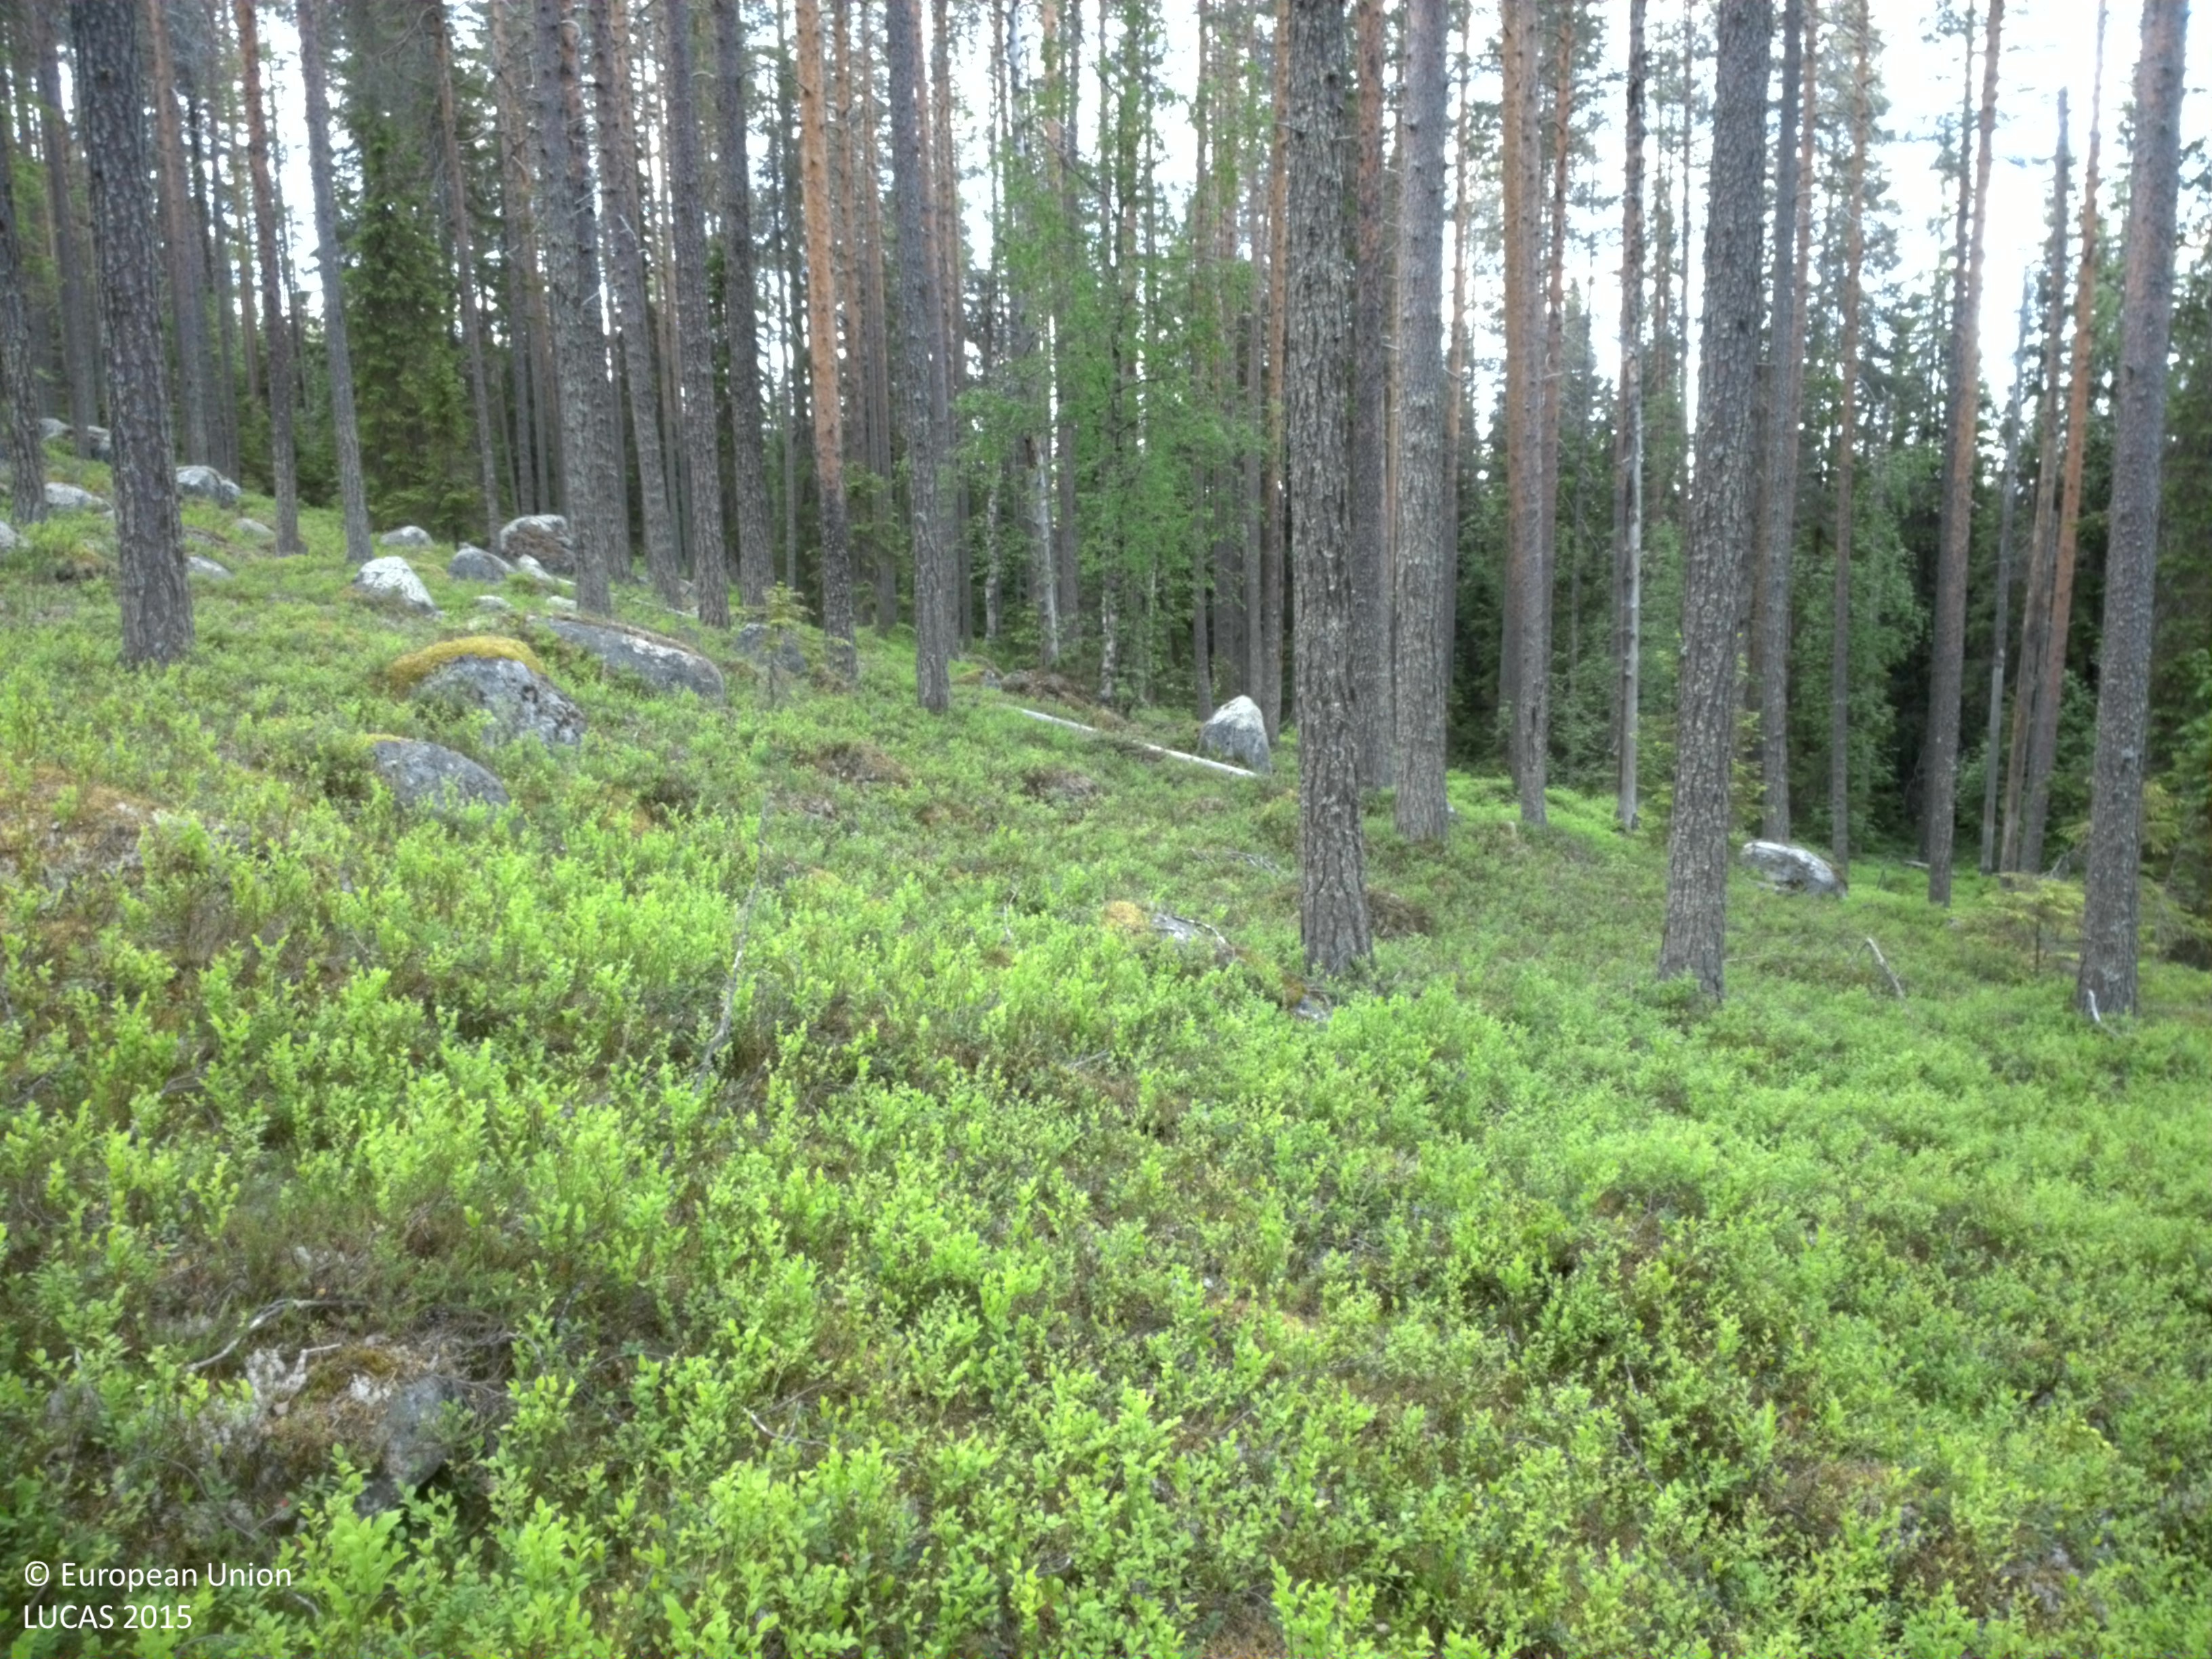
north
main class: Woodland
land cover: Pine dominated coniferous woodland
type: boreal forest
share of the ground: 25 - 50 %
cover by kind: shrubs 50 %, coniferous forest trees 40 %, consolidated bare surface 10 %
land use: Forestry
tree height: > 5 m
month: June
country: SE
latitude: 66.3019
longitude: 22.7985
